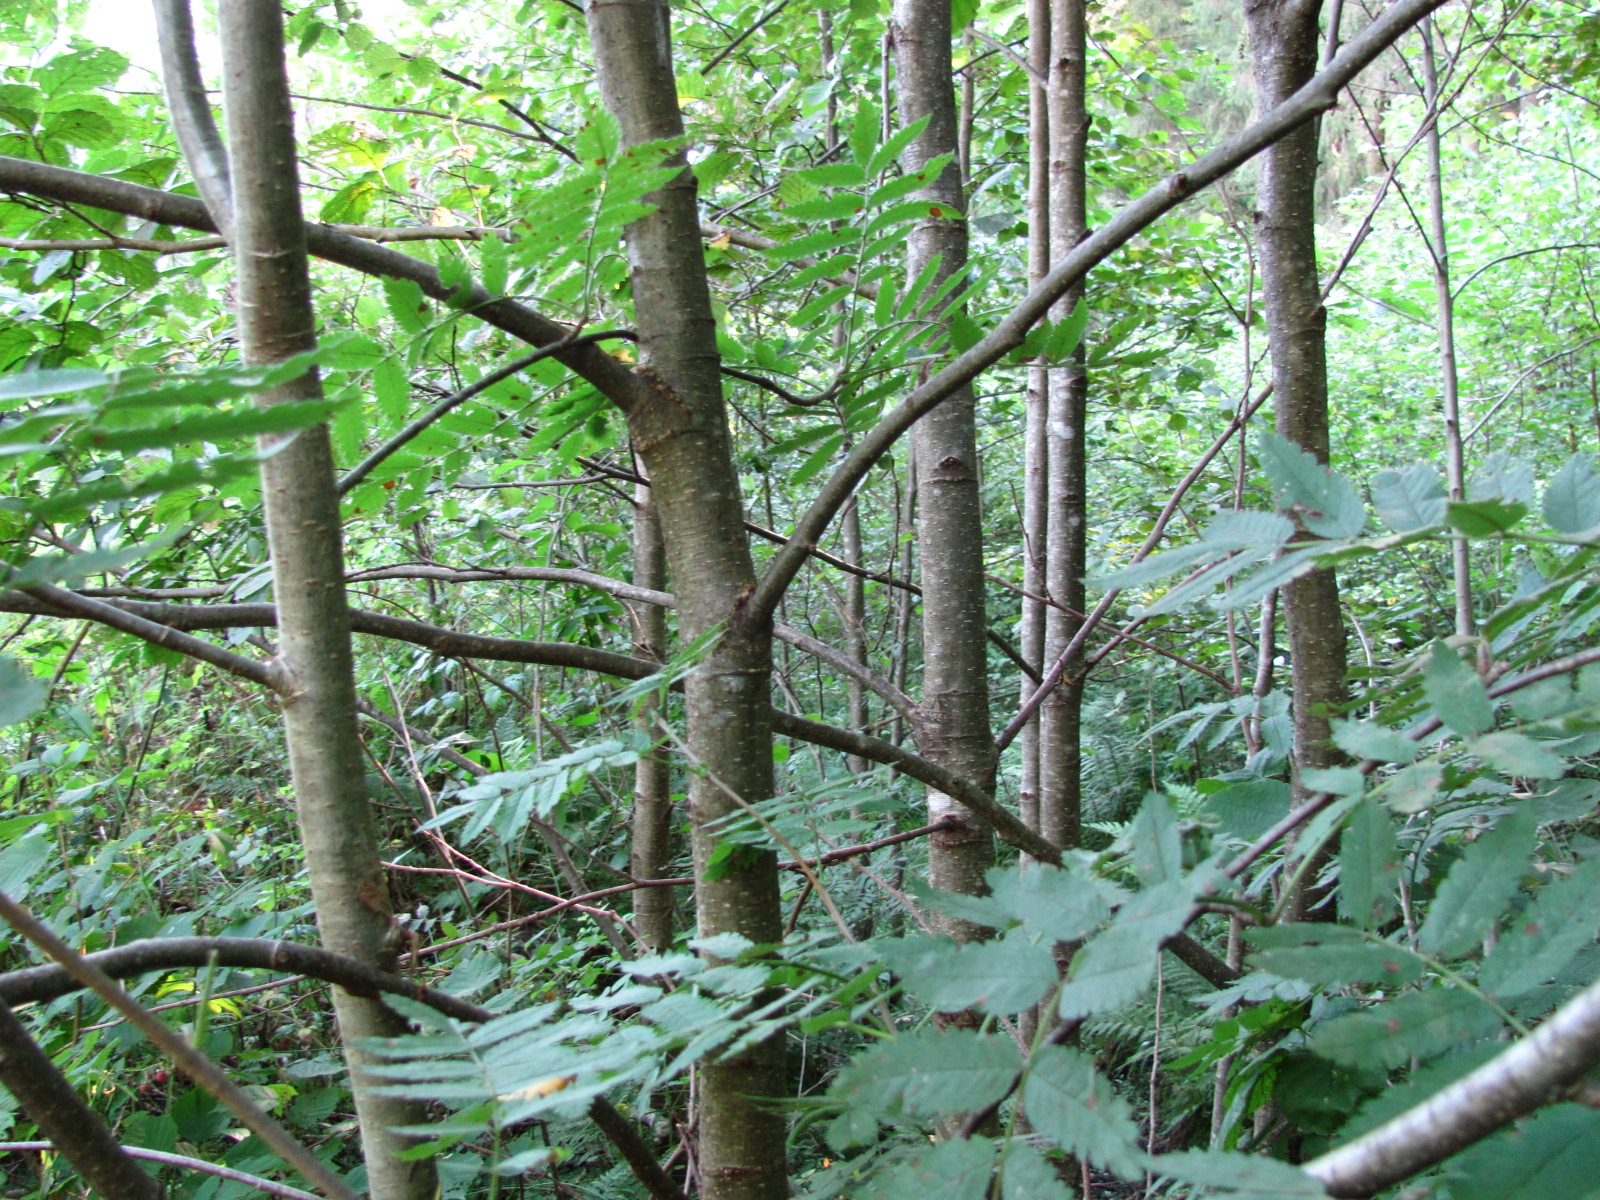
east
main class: Woodland
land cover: Broadleaved woodland
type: non-riverine alder, birch or aspen forest
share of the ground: > 75 %
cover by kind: broadleaved forest trees 85 %, herbaceous plants 15 %
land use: Forestry
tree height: > 5 m
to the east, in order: Broadleaved woodland; Ditches and canals; Broadleaved woodland; Other coniferous woodland; Spruce dominated mixed woodland; Broadleaved woodland; Ditches and canals; Broadleaved woodland
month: August
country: LV
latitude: 56.6688
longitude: 23.9037
